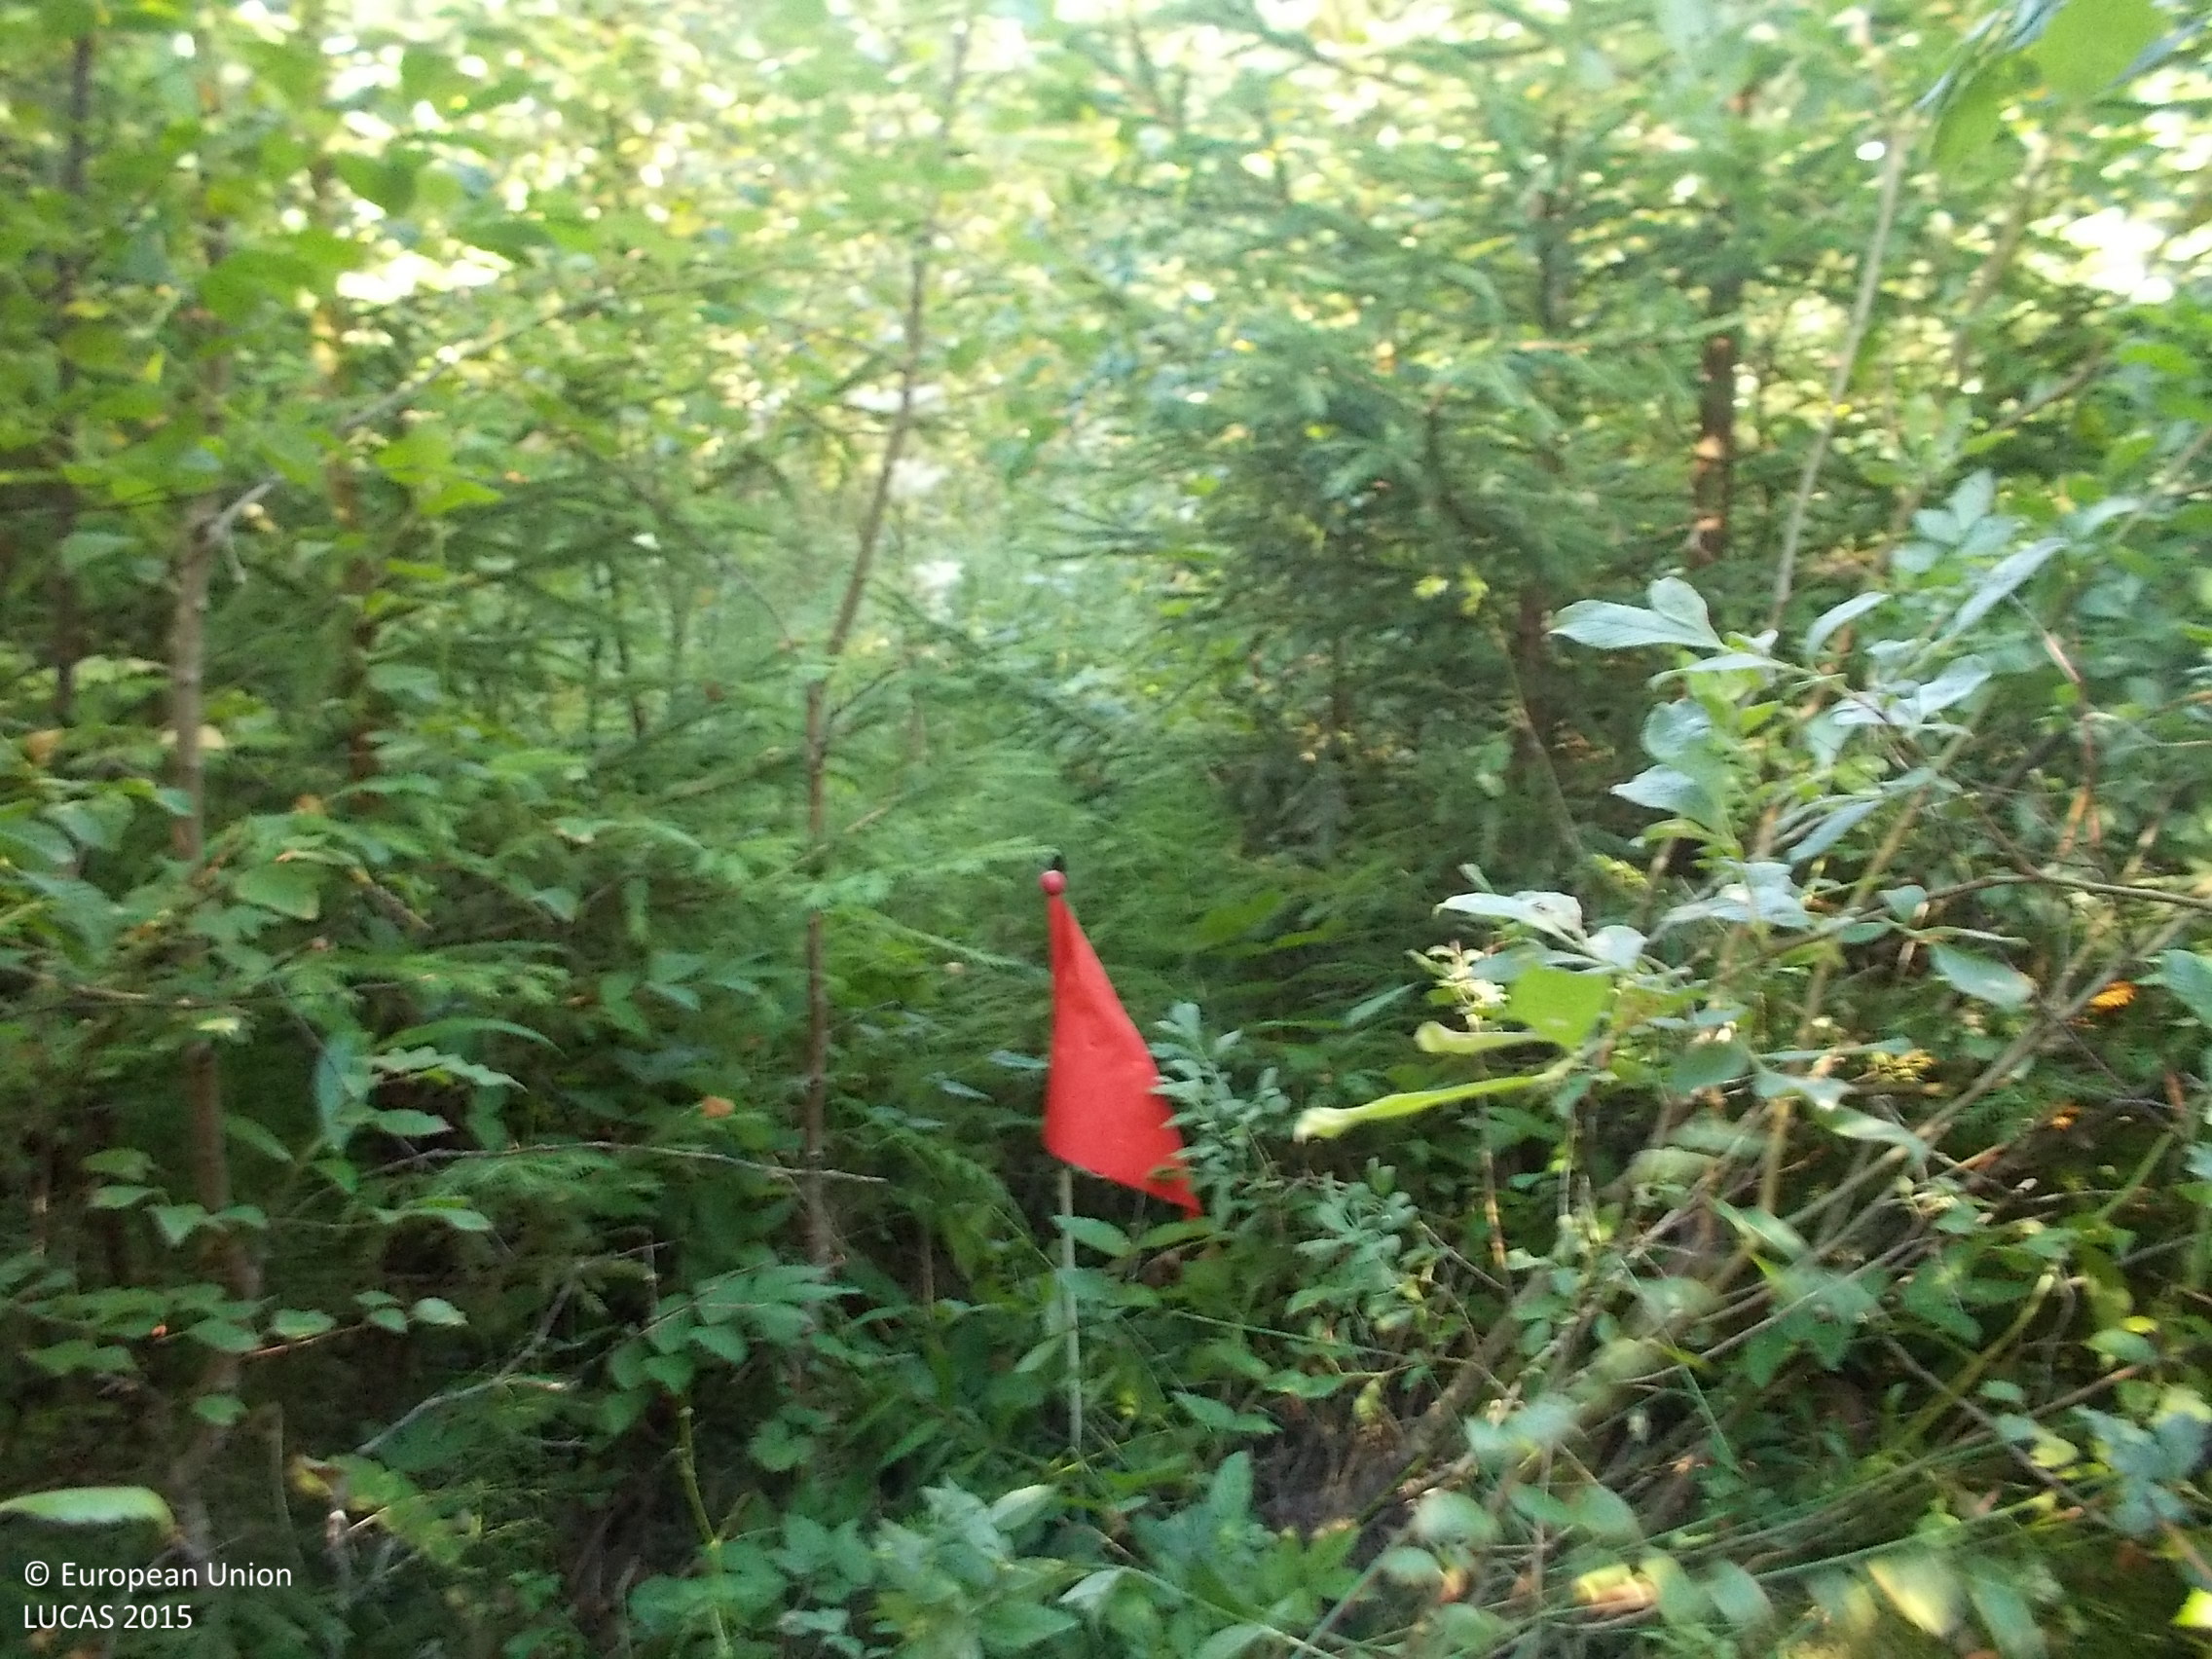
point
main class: Woodland
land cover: Spruce dominated mixed woodland
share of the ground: > 75 %
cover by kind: broadleaved forest trees 60 %, coniferous forest trees 30 %, herbaceous plants 10 %
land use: Forestry
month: August
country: SE
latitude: 57.5681
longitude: 13.2556
